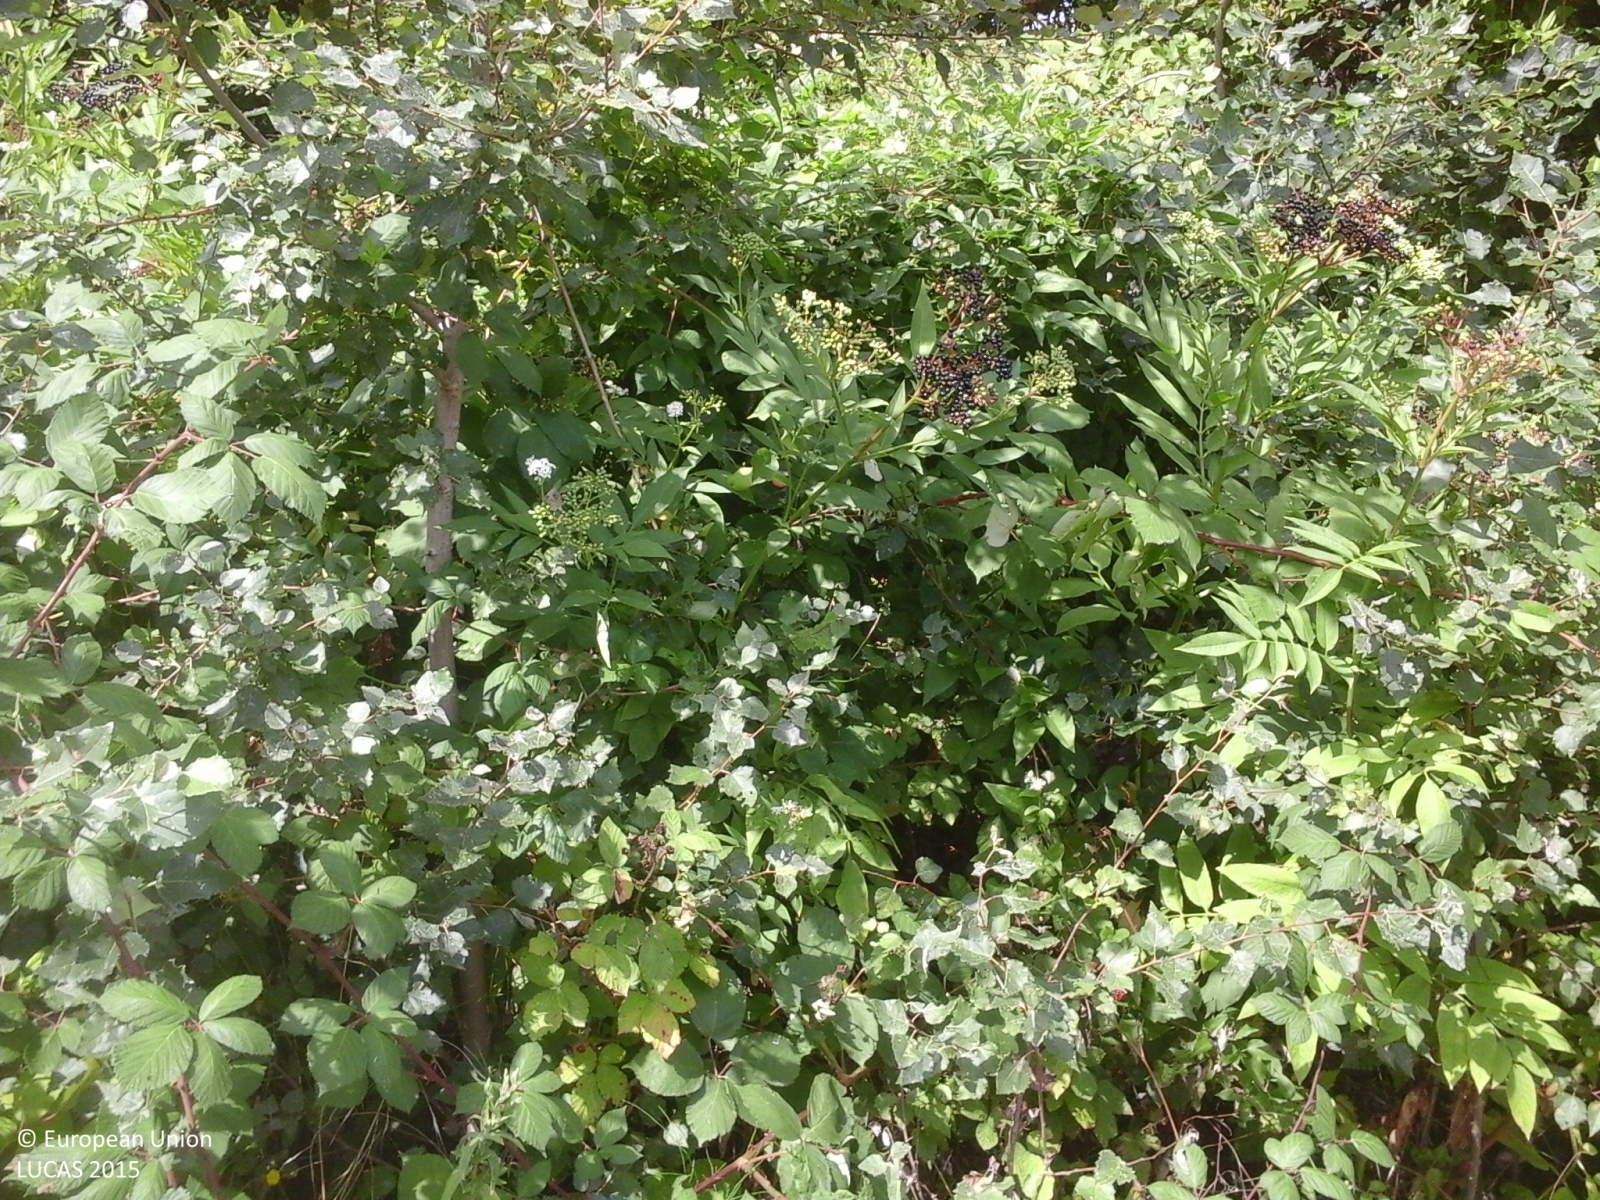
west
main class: Woodland
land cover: Broadleaved woodland
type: thermophilous deciduous forest
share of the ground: > 75 %
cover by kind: broadleaved forest trees 100 %
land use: Abandoned areas
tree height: > 5 m
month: August
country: IT
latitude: 43.9136
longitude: 10.9067
